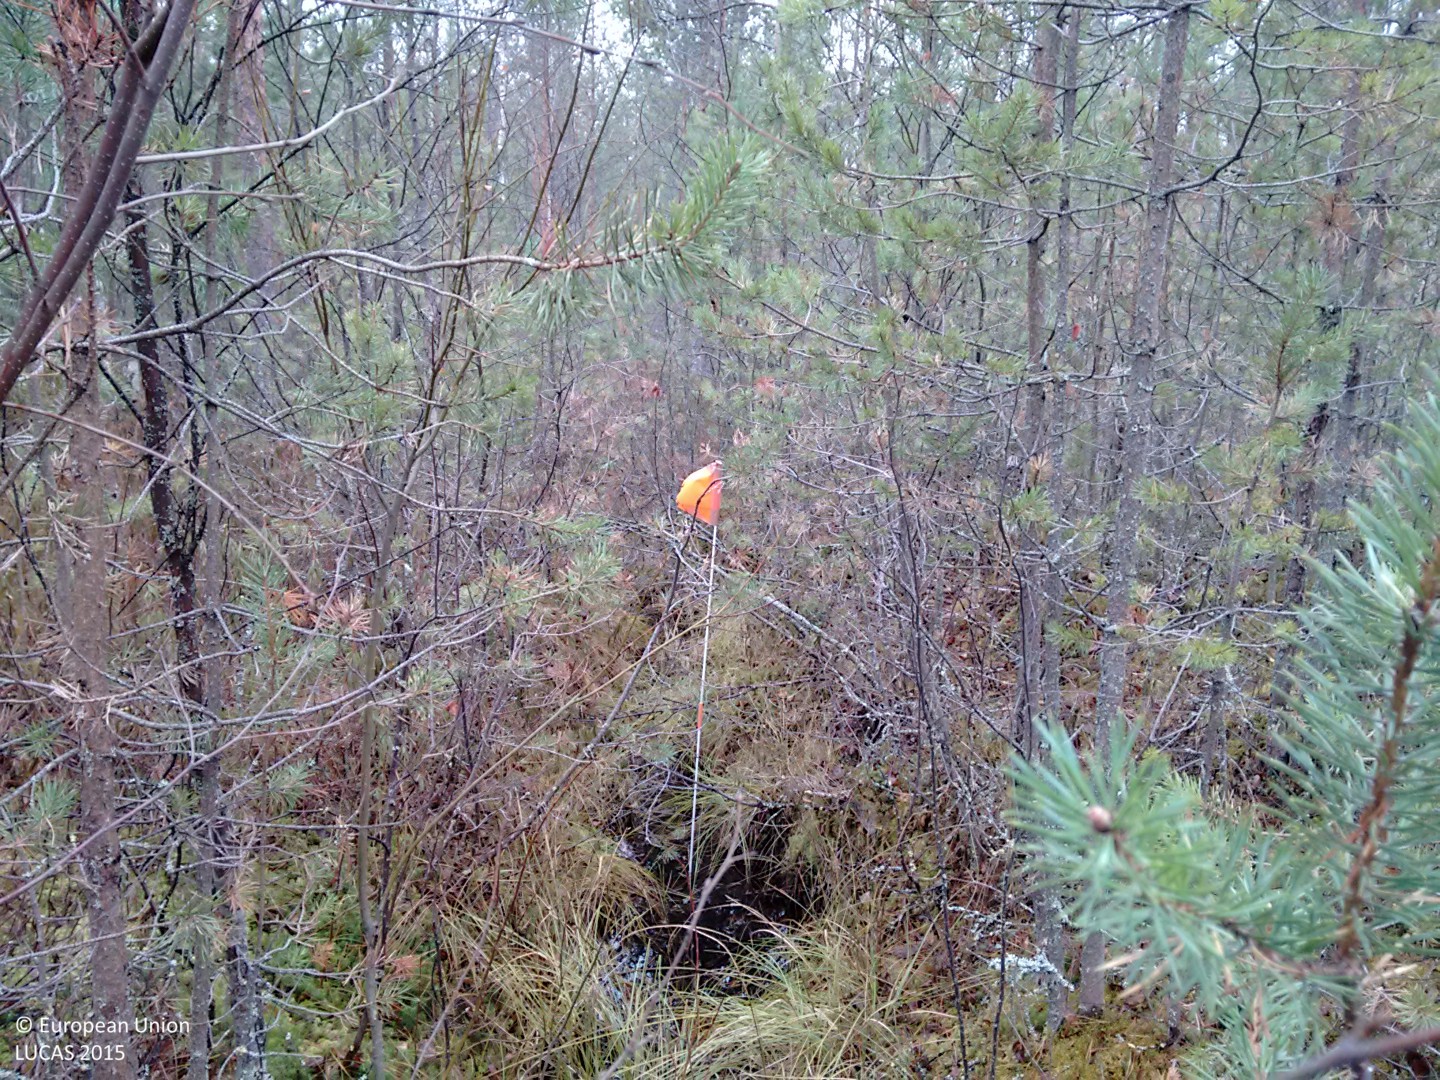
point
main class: Woodland
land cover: Pine dominated coniferous woodland
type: boreal forest
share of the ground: > 75 %
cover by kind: coniferous forest trees 70 %, broadleaved forest trees 10 %, shrubs 10 %, herbaceous plants 5 %, lichens and mosses 5 %
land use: Forestry
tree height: > 5 m
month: October
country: FI
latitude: 64.4819
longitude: 25.2938
